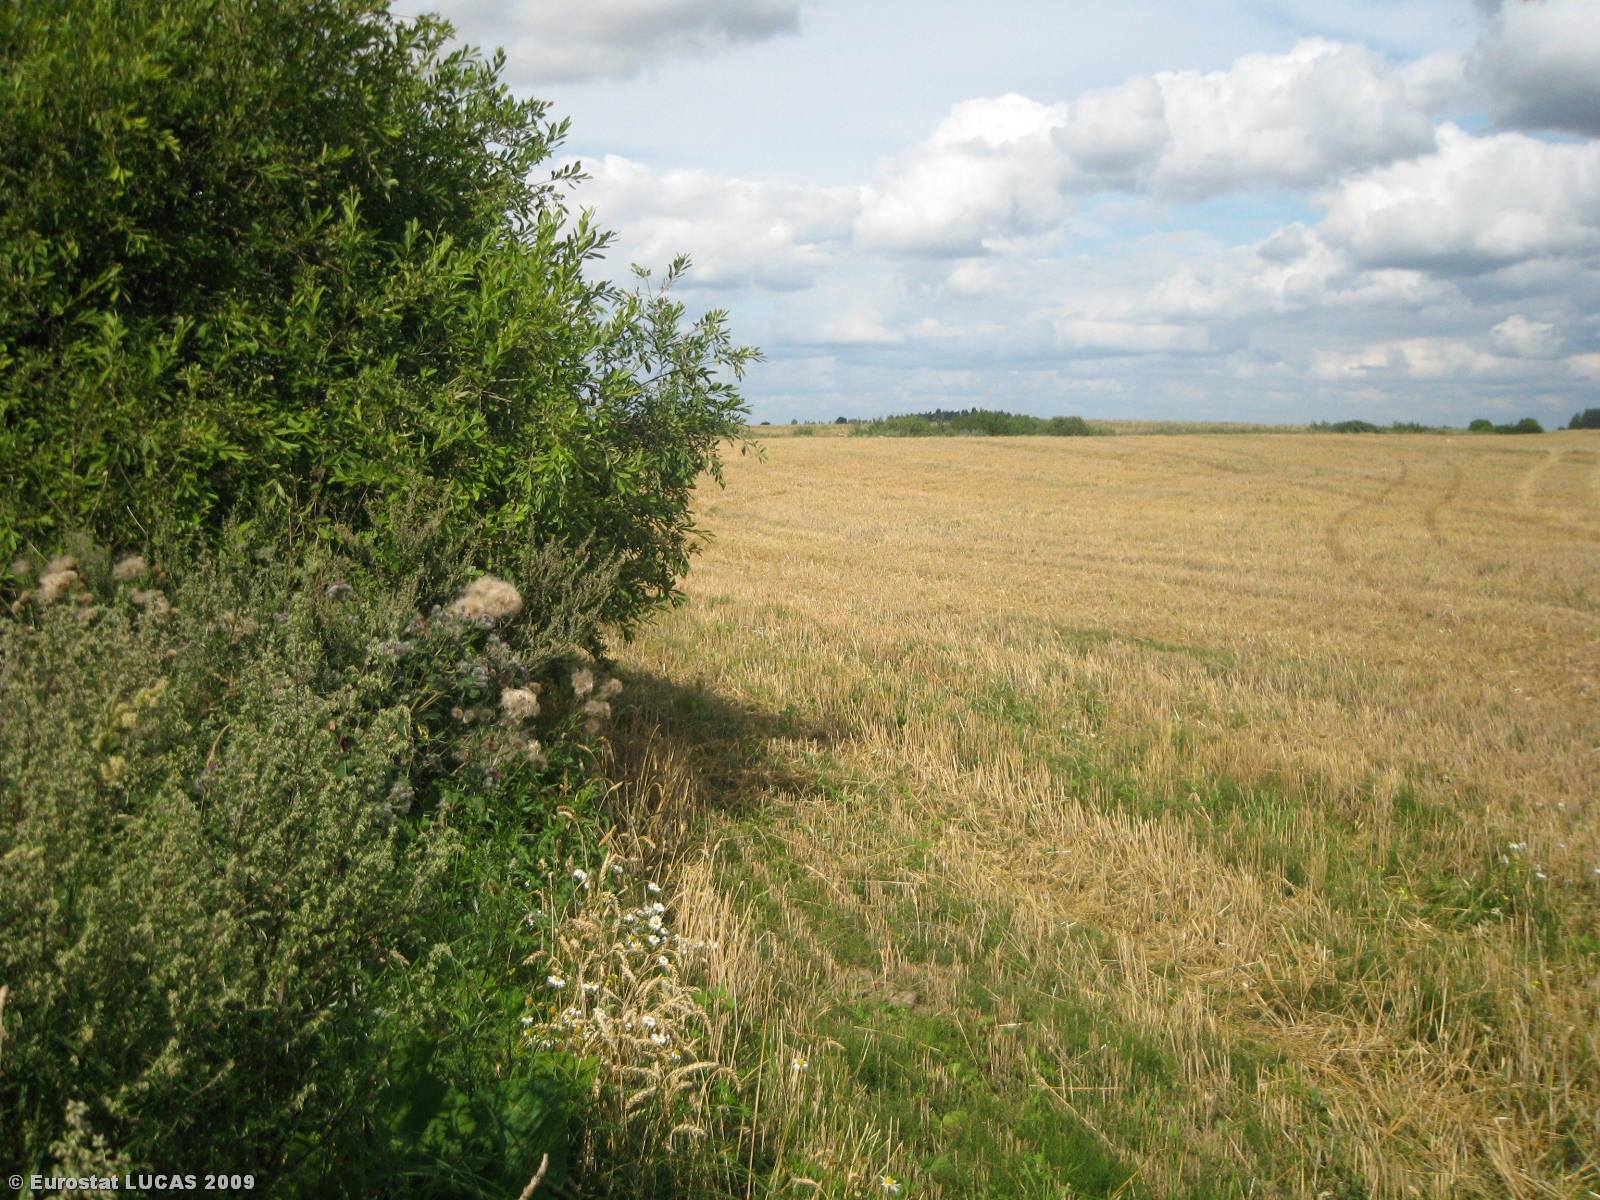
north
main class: Grassland
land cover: Spontaneously vegetated surfaces
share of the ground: > 75 %
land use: Fallow land
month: August
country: LT
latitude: 55.3783
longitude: 23.6711
